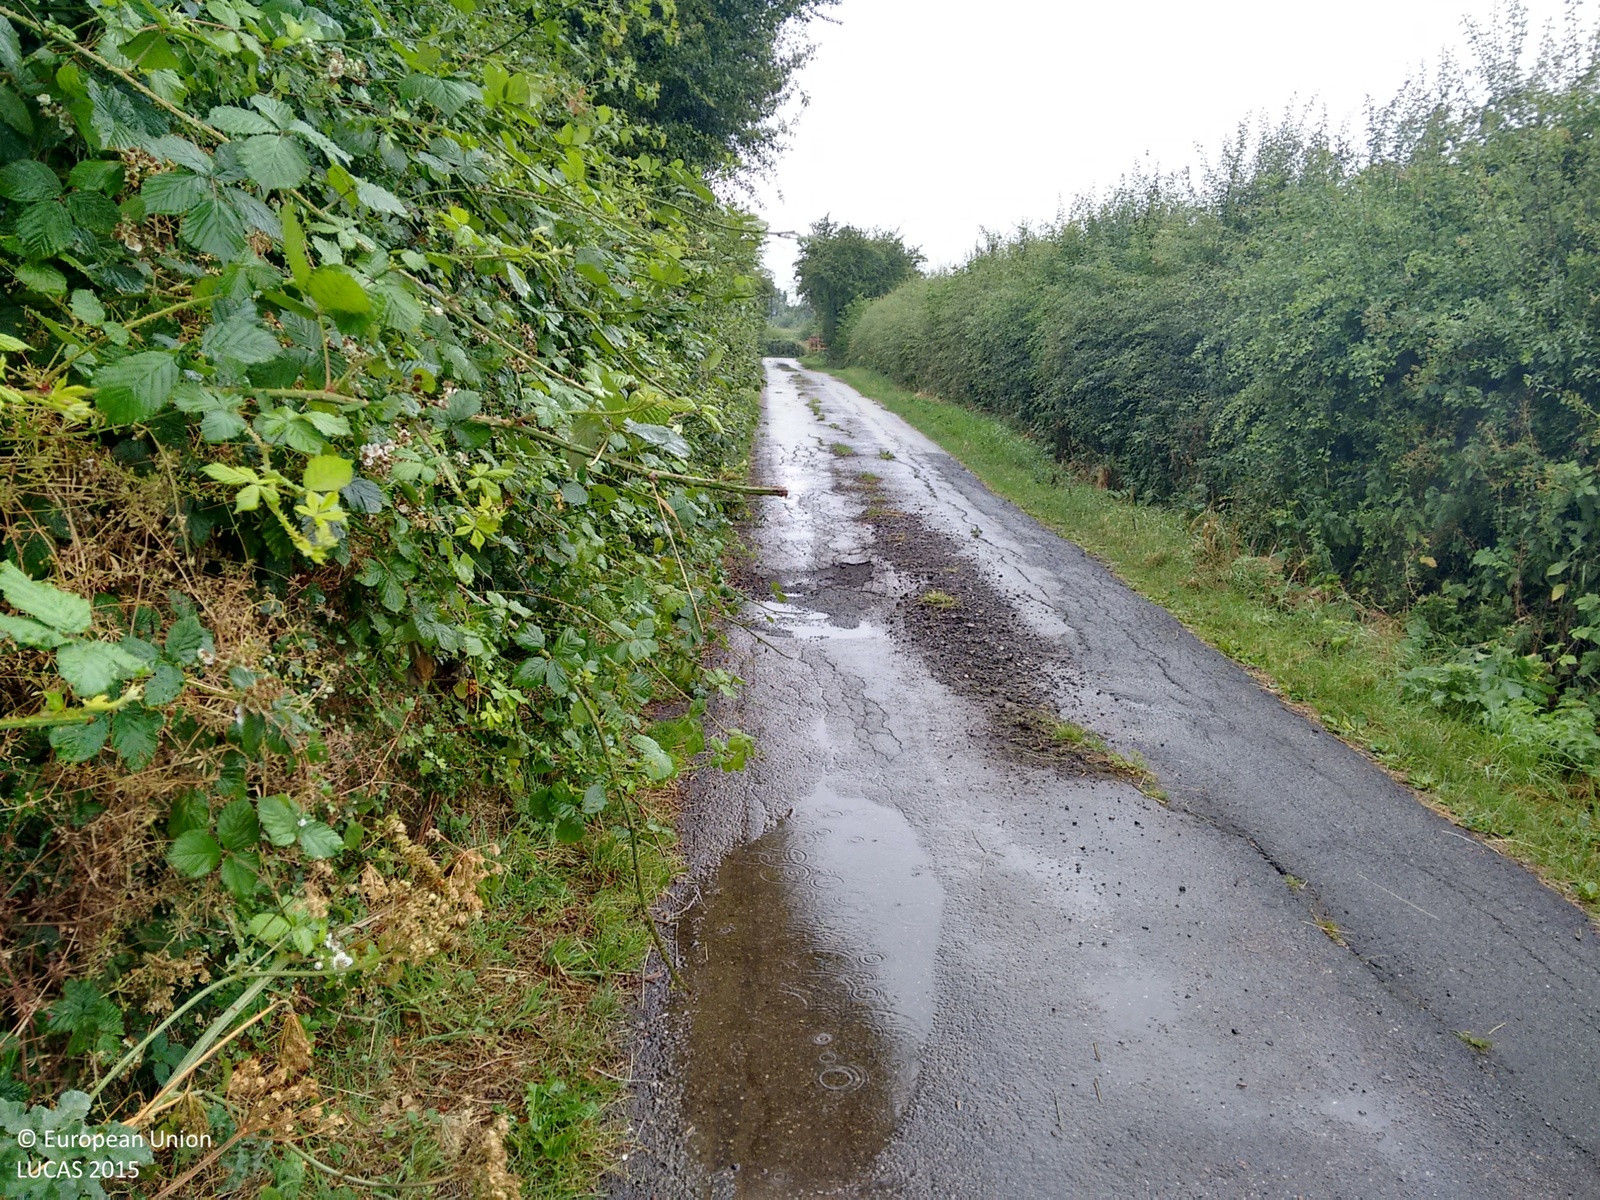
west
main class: Grassland
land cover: Grassland without tree/shrub cover
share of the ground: > 75 %
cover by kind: herbaceous plants 100 %
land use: Agriculture (excluding fallow land and kitchen gardens)
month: July
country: GB
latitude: 52.8363
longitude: -0.8939
